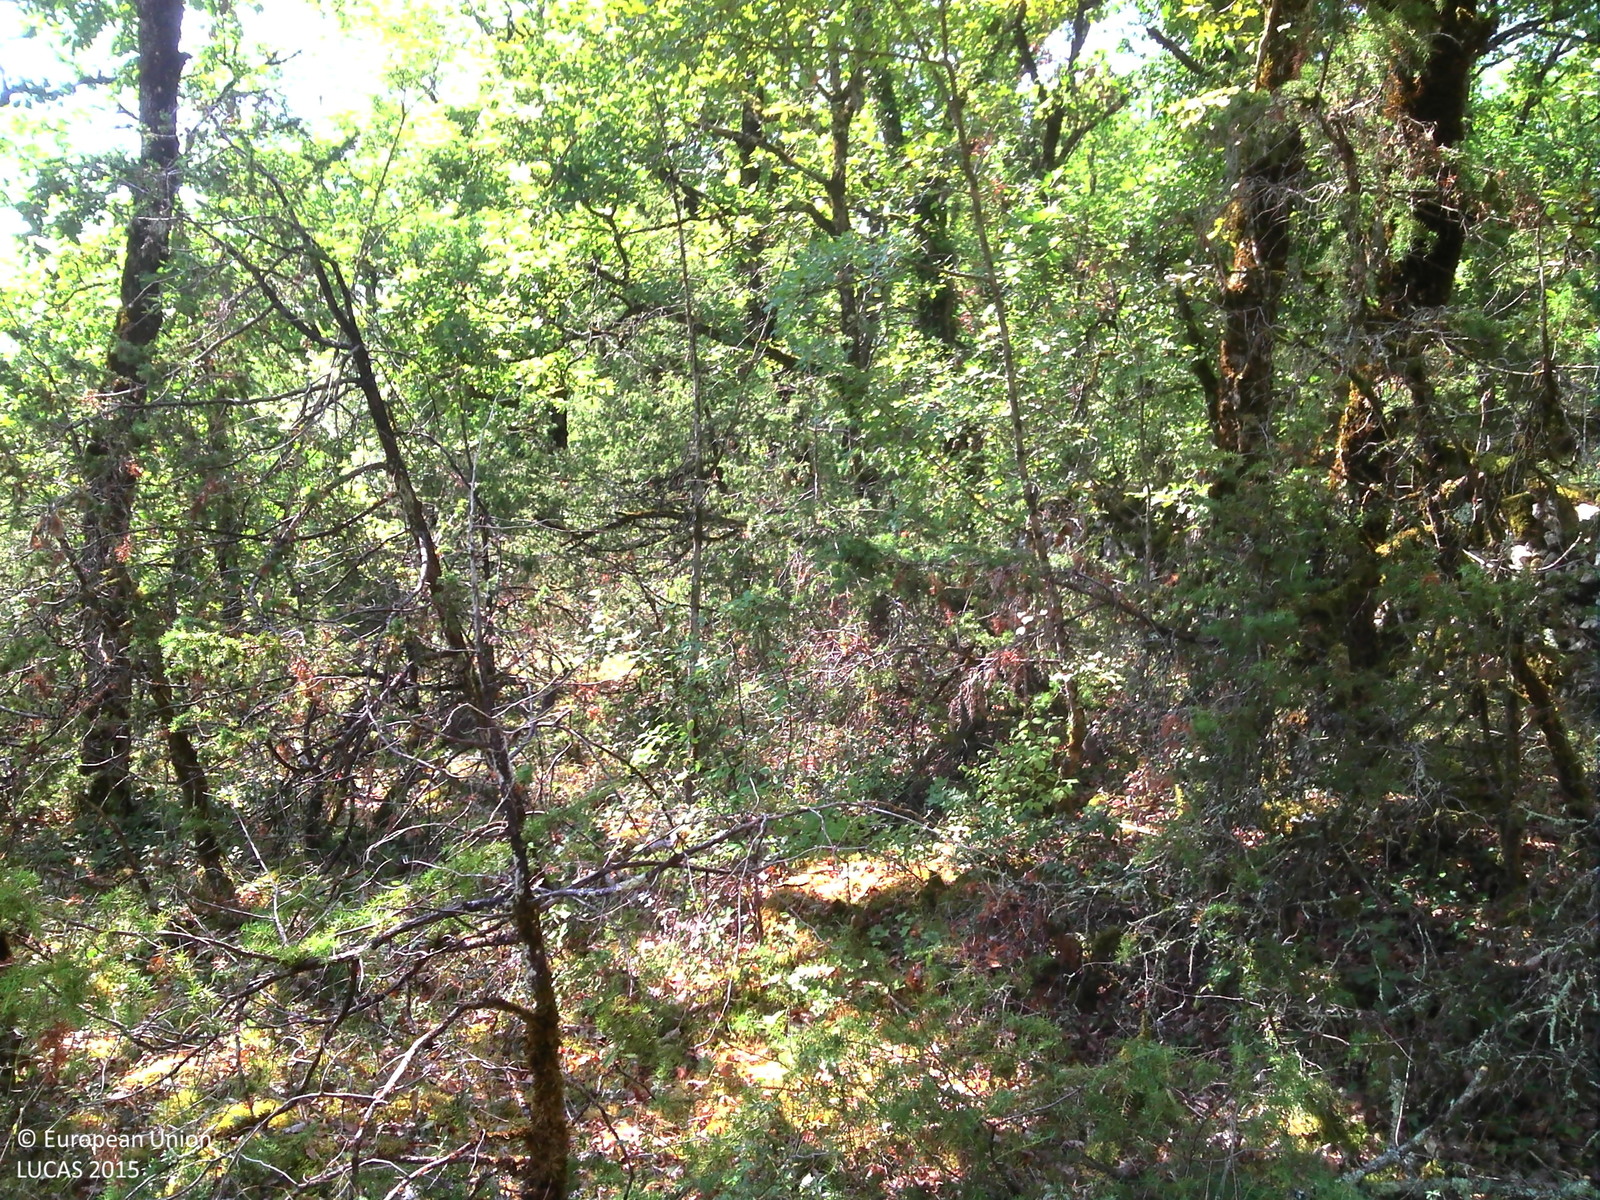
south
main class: Woodland
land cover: Broadleaved woodland
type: thermophilous deciduous forest
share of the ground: > 75 %
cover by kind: broadleaved forest trees 75 %, shrubs 10 %, unconsolidated bare surface 10 %, herbaceous plants 5 %
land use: Semi-natural and natural areas not in use
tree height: > 5 m
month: September
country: FR
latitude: 44.5892
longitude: 1.8244
